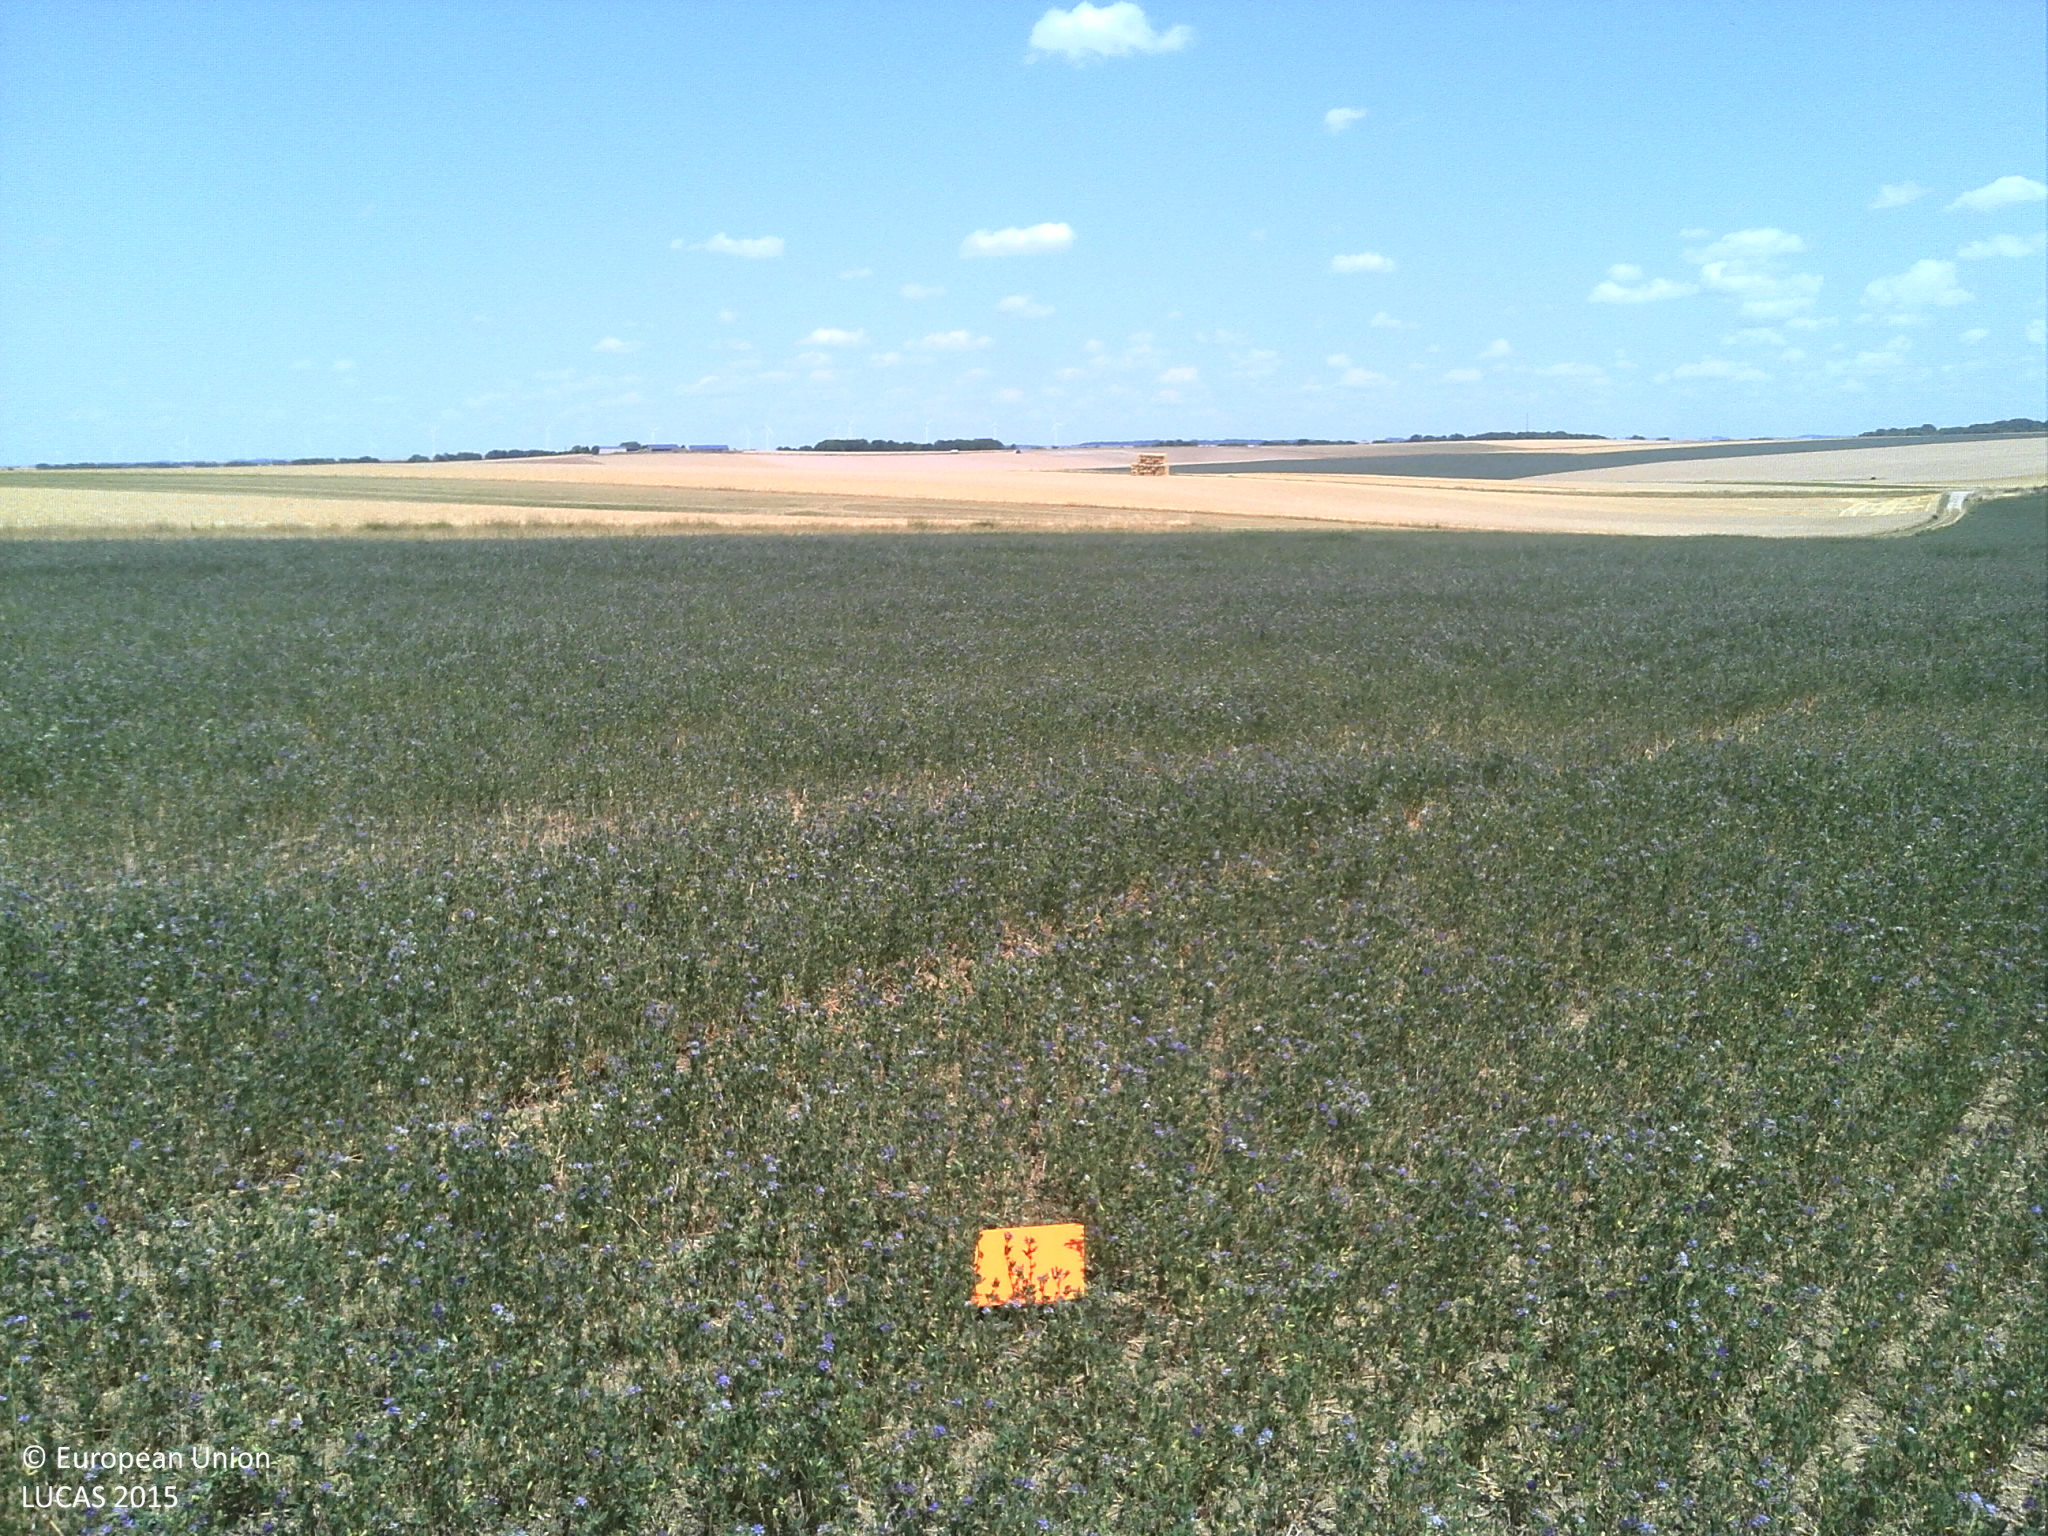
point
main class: Cropland
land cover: Lucerne
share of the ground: > 75 %
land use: Agriculture (excluding fallow land and kitchen gardens)
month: July
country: FR
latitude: 49.4561
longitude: 4.1320
